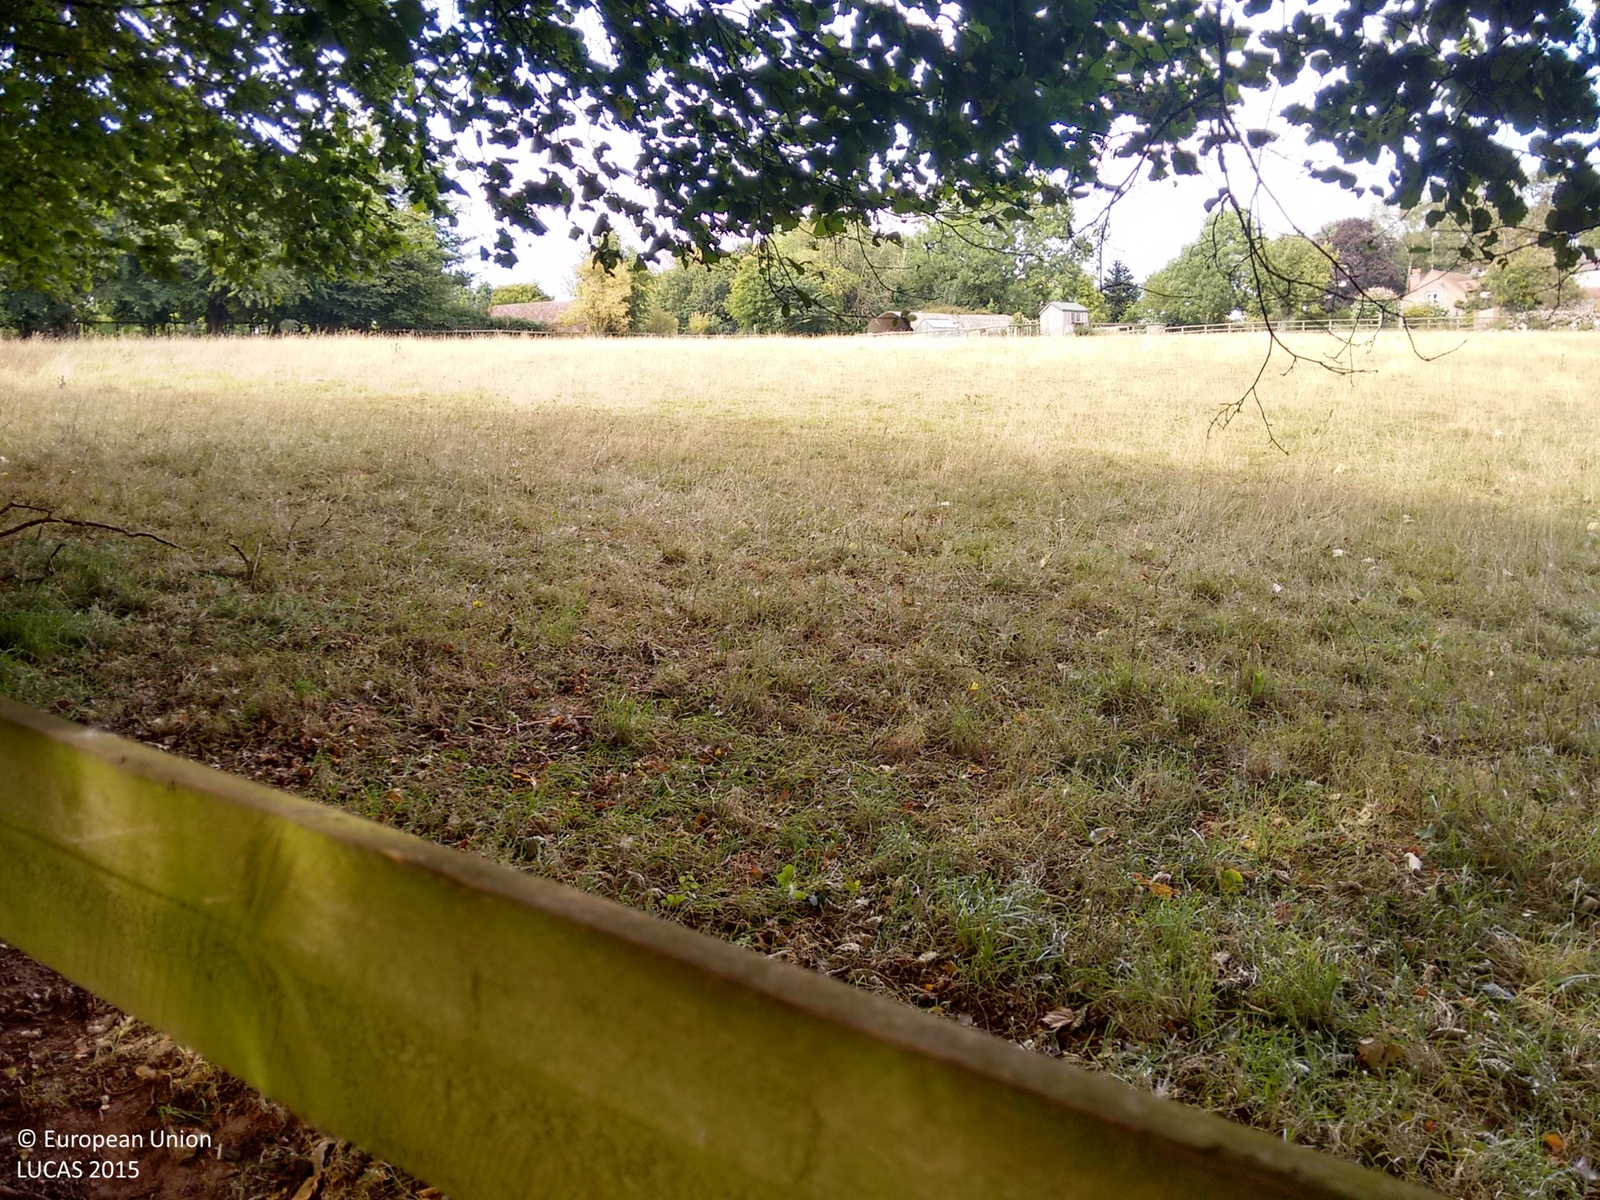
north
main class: Grassland
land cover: Grassland without tree/shrub cover
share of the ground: > 75 %
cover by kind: herbaceous plants 100 %
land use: Agriculture (excluding fallow land and kitchen gardens)
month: August
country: GB
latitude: 51.8924
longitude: -2.6972
